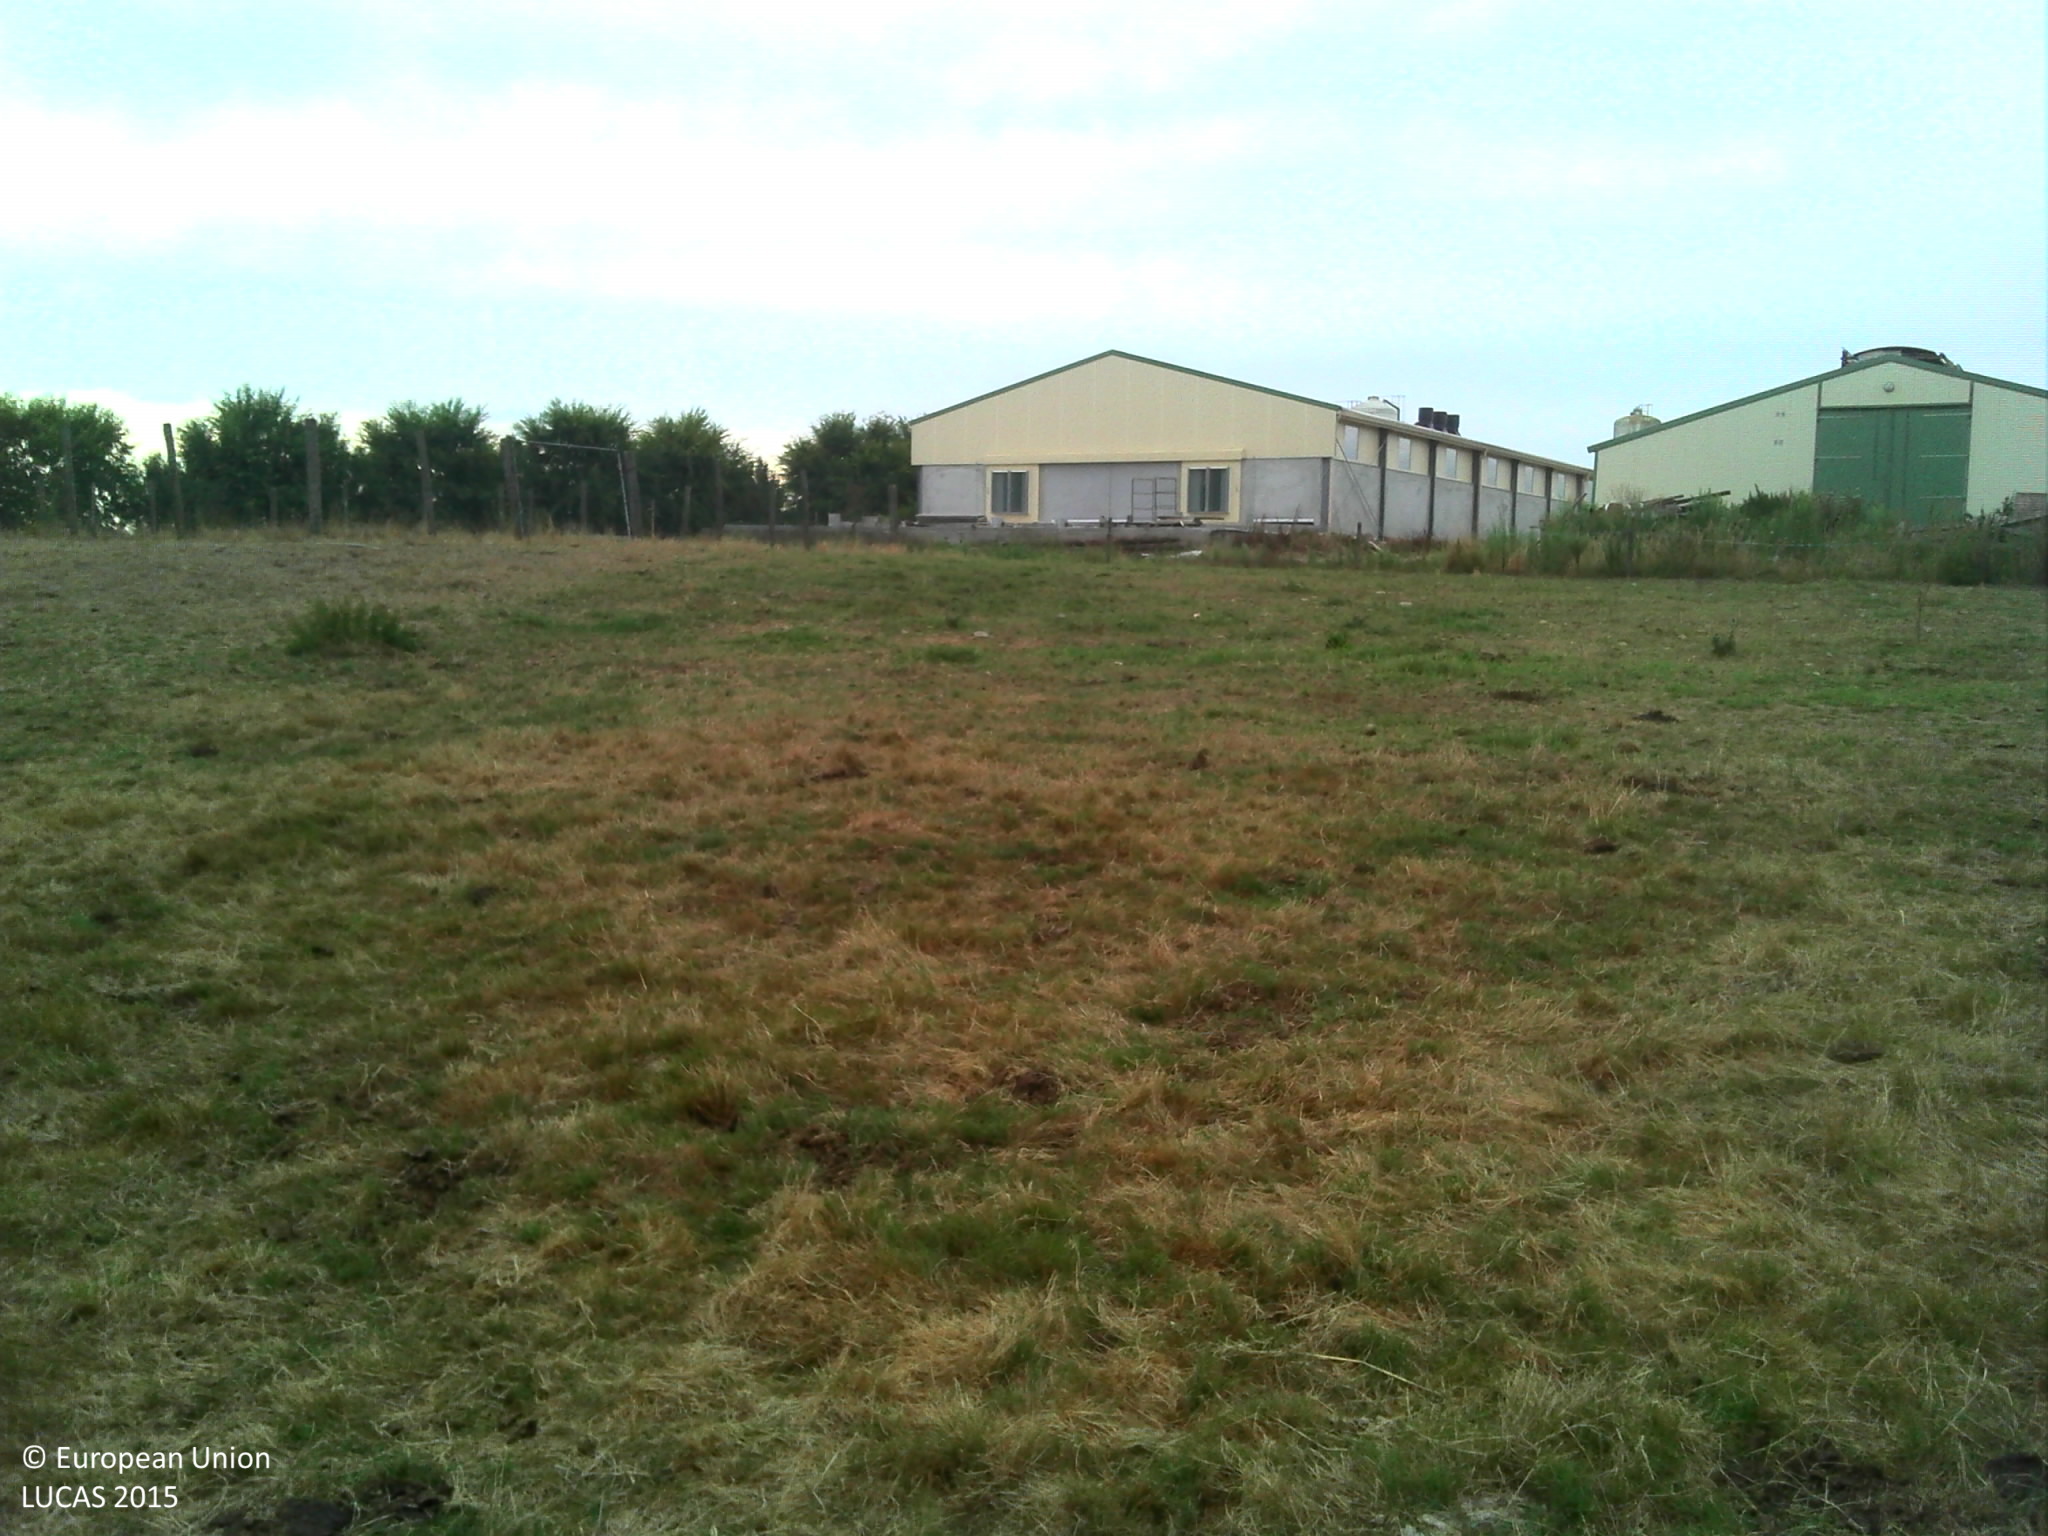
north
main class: Grassland
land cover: Grassland without tree/shrub cover
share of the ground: > 75 %
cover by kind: herbaceous plants 100 %
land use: Agriculture (excluding fallow land and kitchen gardens)
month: July
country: FR
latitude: 46.8518
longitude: -1.1967
